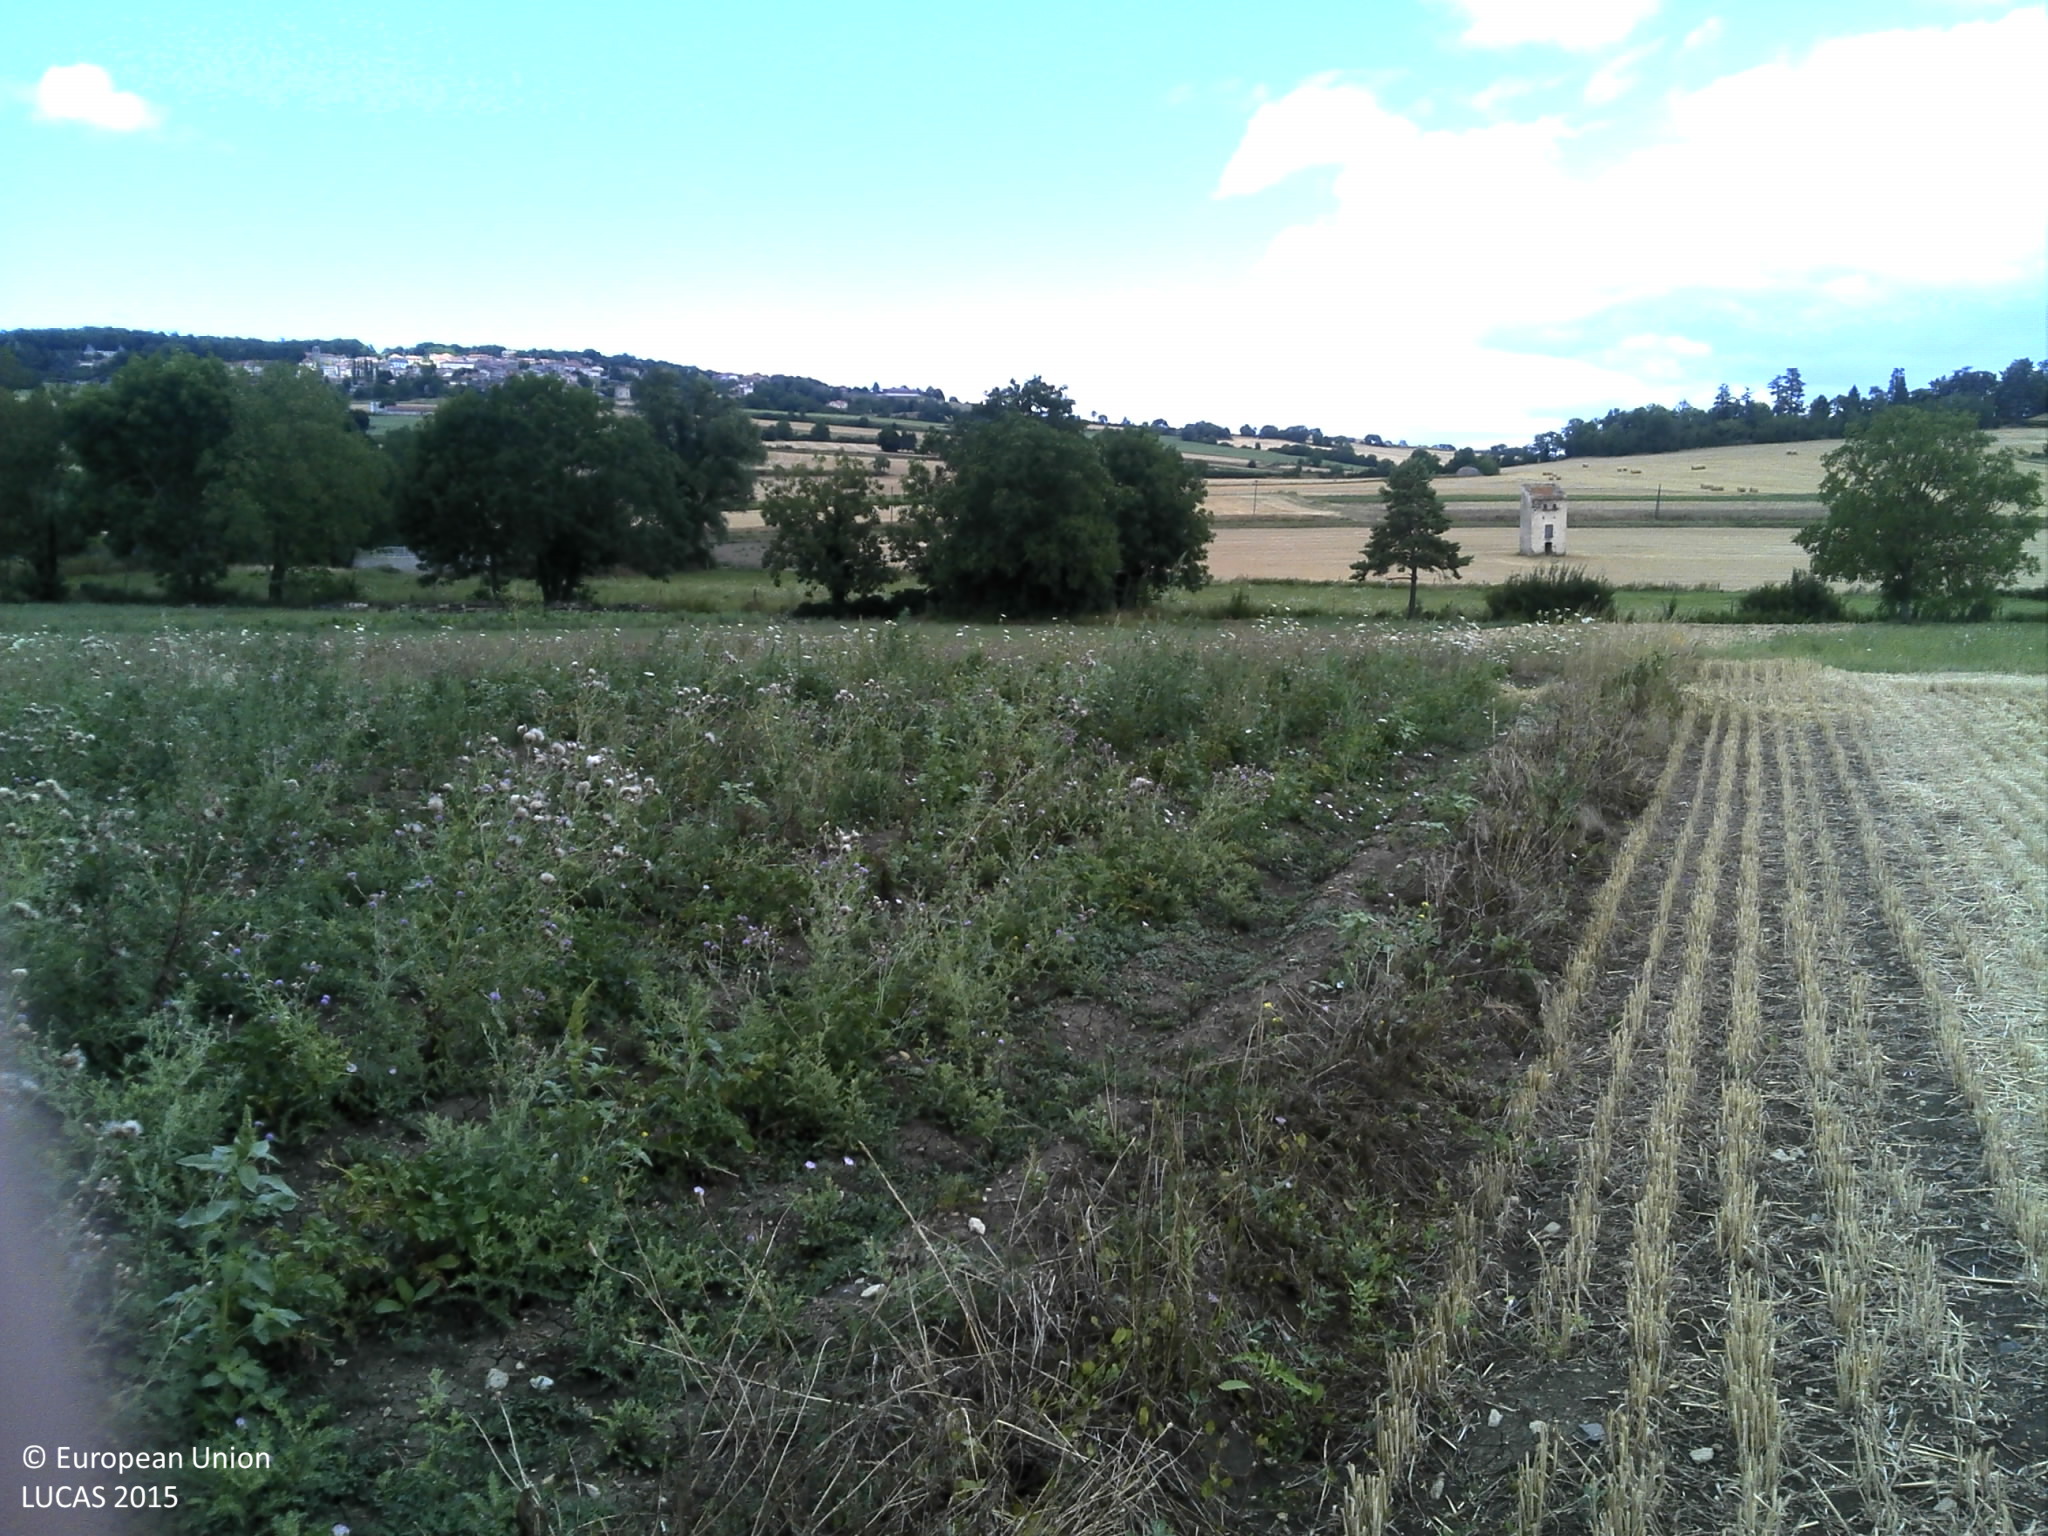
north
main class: Cropland
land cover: Potatoes
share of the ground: < 10 %
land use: Kitchen garden
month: July
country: FR
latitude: 45.5007
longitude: 3.1797
